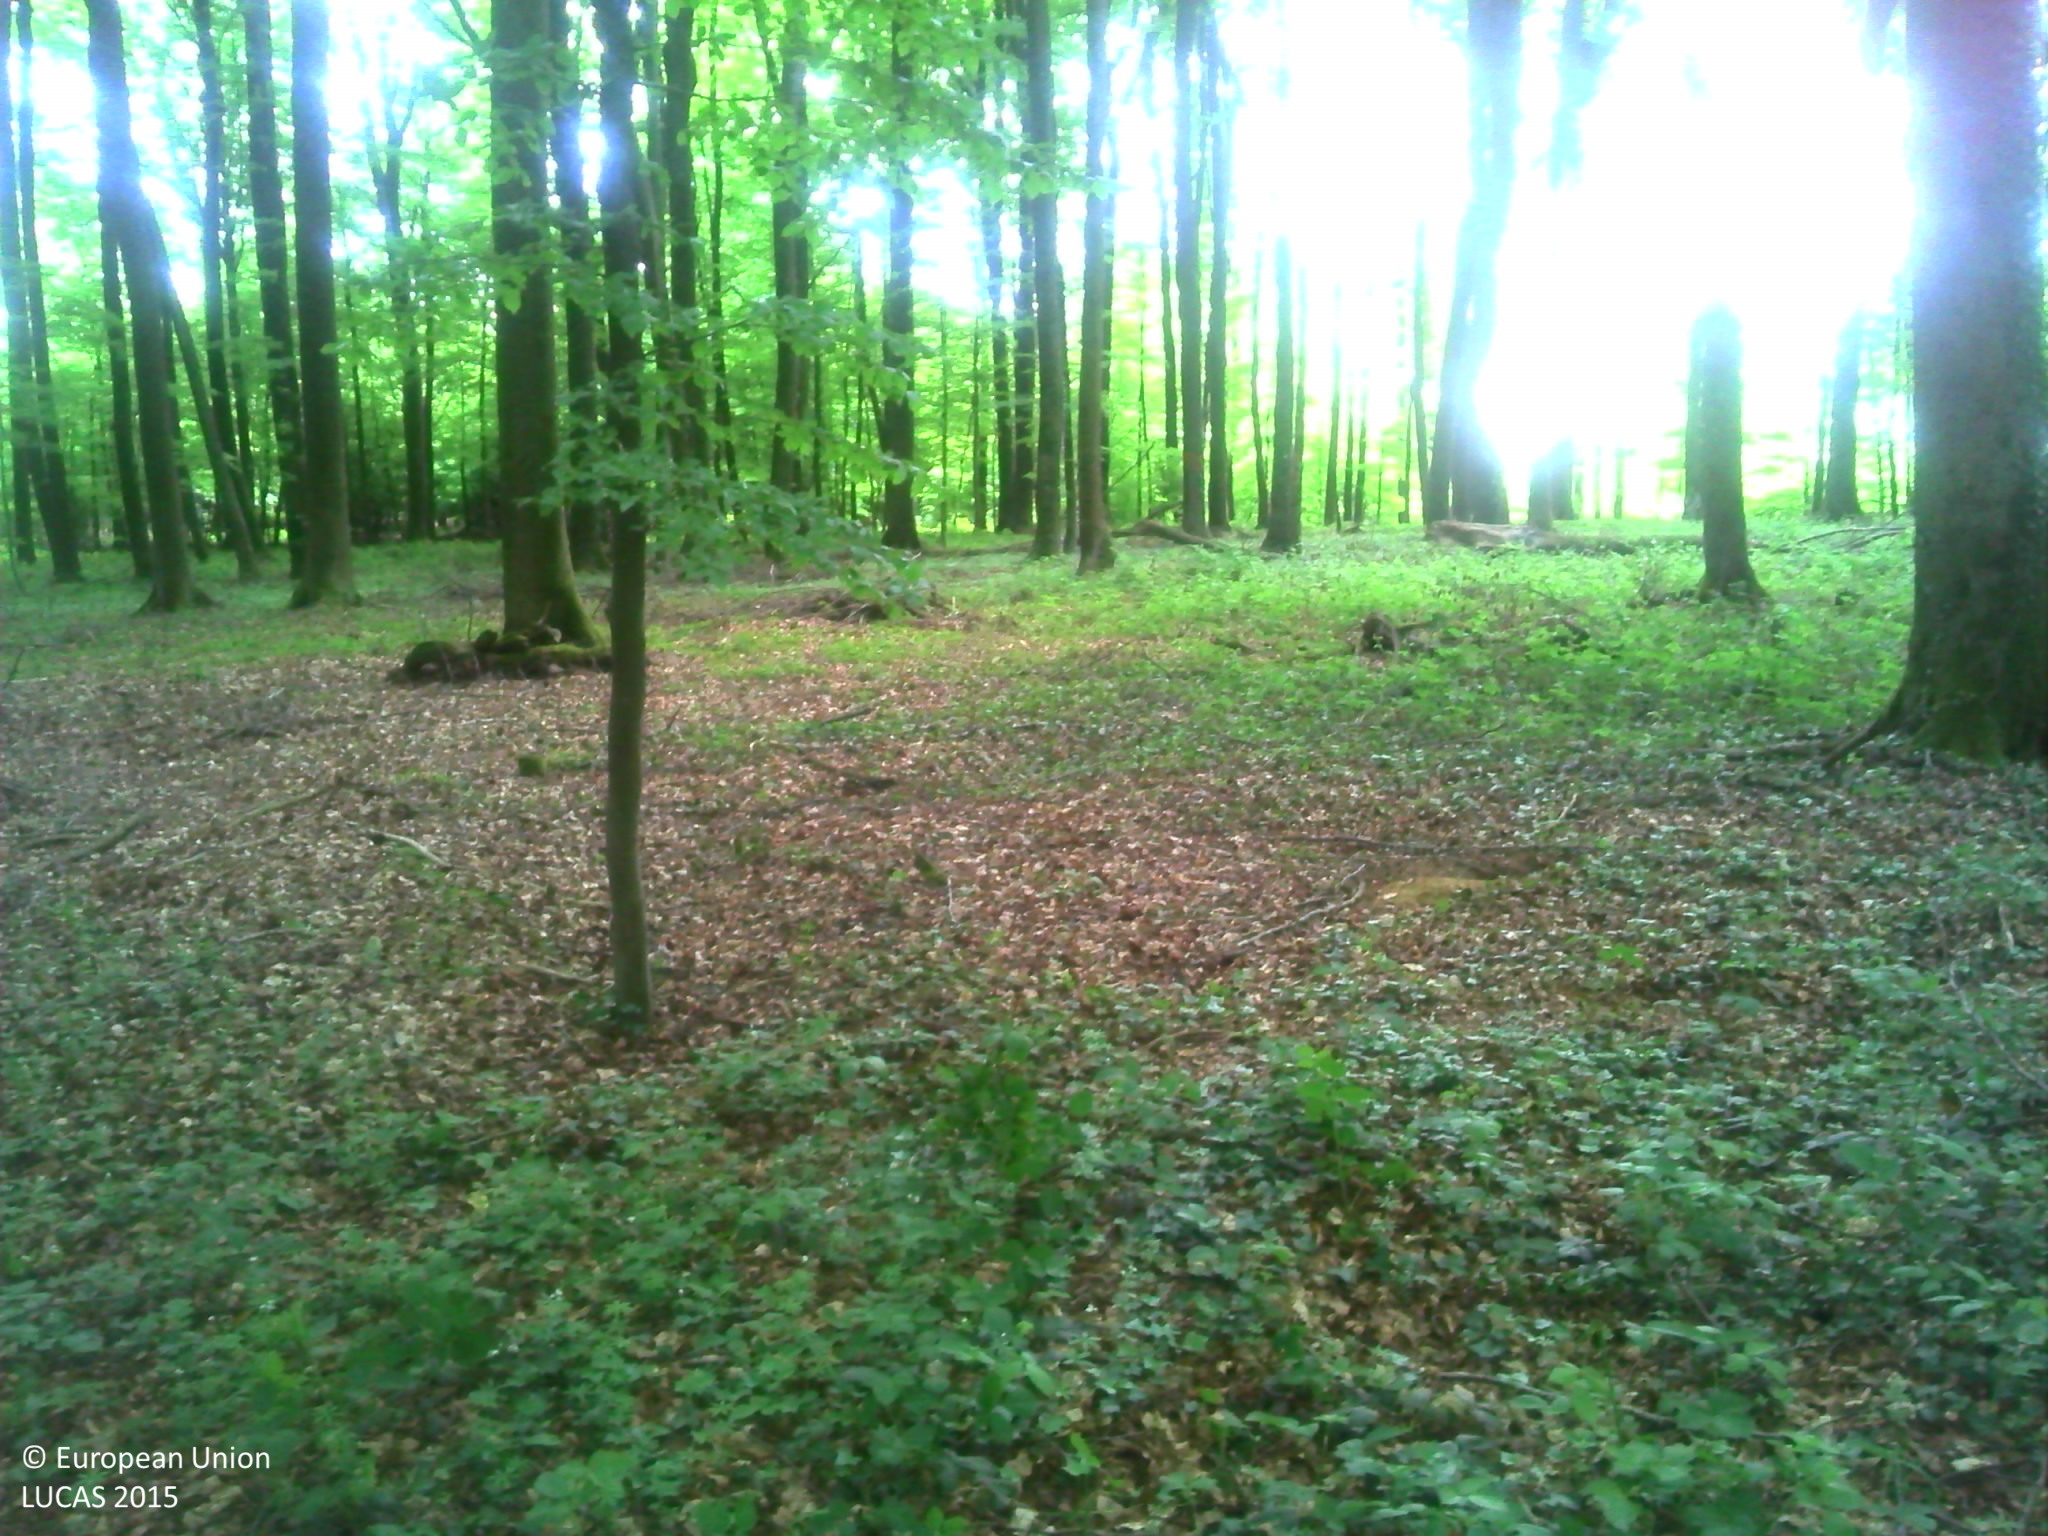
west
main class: Woodland
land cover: Broadleaved woodland
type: beech forest
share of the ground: > 75 %
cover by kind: broadleaved forest trees 90 %, herbaceous plants 10 %
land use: Forestry
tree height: > 5 m
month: May
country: LU
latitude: 49.7167
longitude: 5.9631
